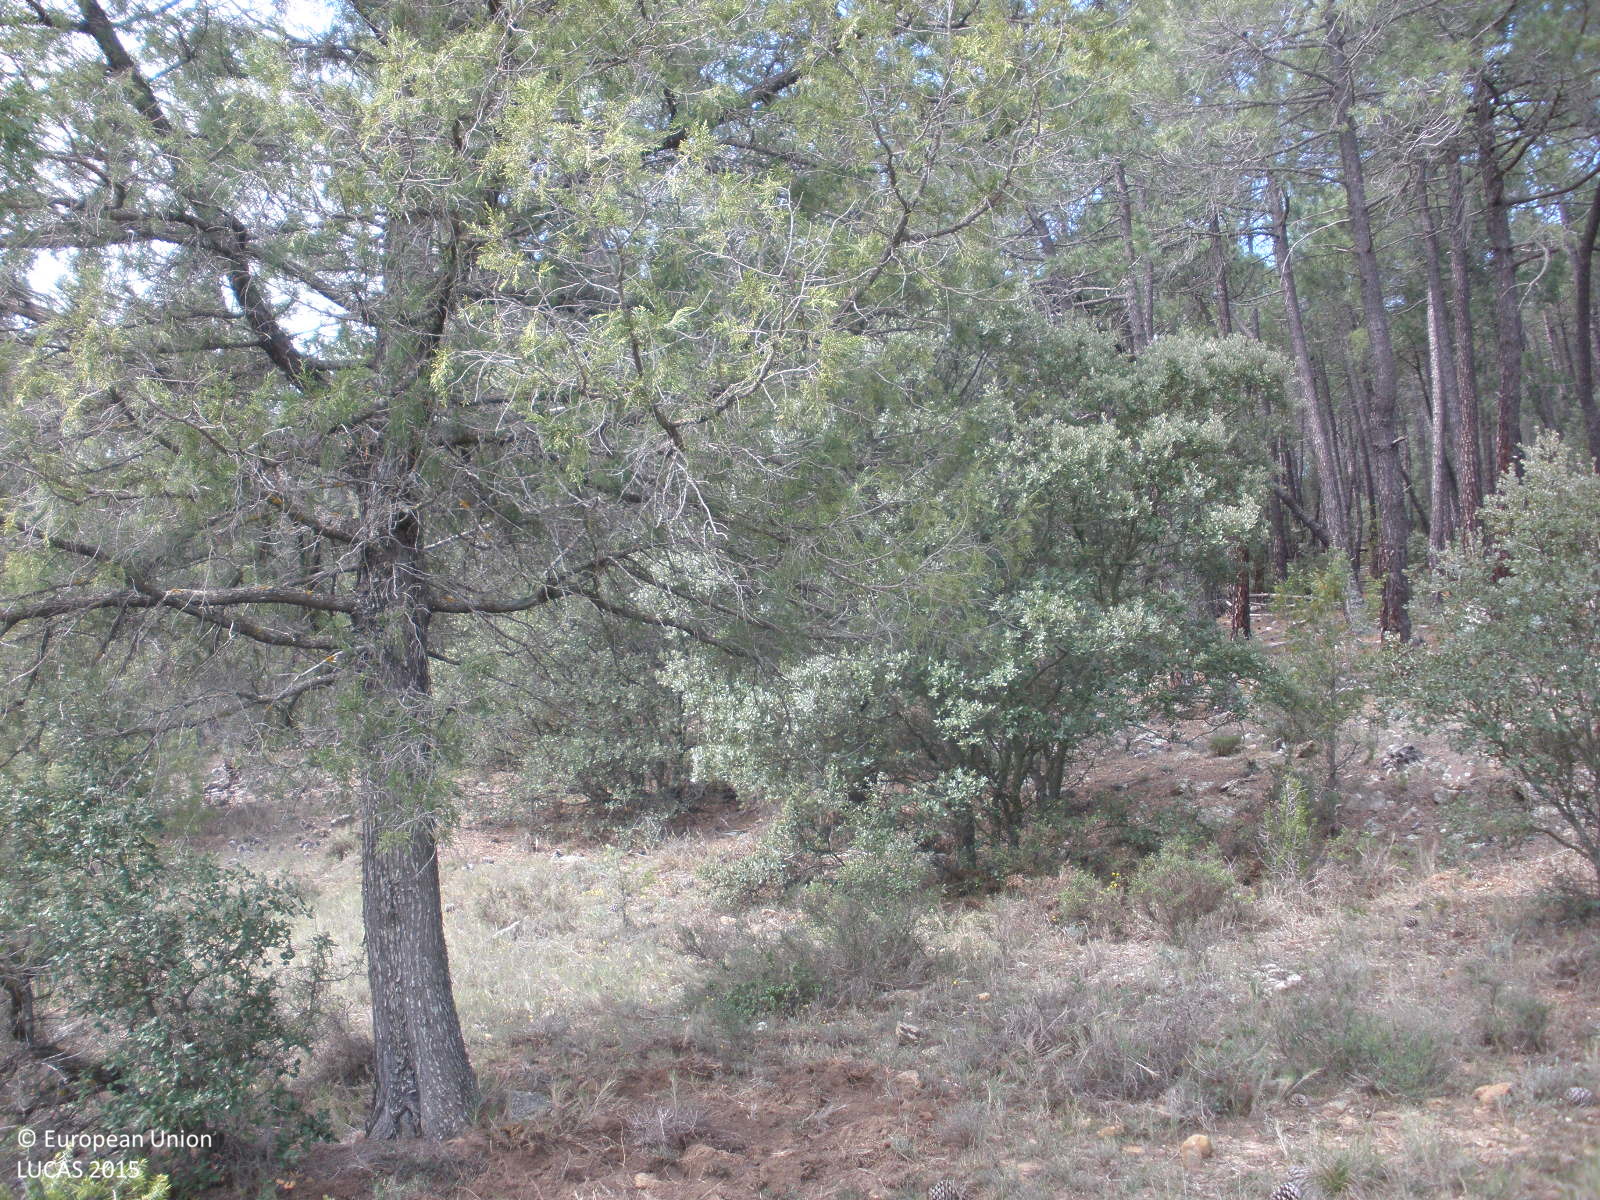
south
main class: Woodland
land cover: Other coniferous woodland
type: coniferous forest of the mediterranean region
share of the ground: 50 - 75 %
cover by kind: coniferous forest trees 50 %, shrubs 30 %, herbaceous plants 10 %, unconsolidated bare surface 10 %
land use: Forestry
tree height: < 5 m
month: April
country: ES
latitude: 40.2695
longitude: -0.8150
